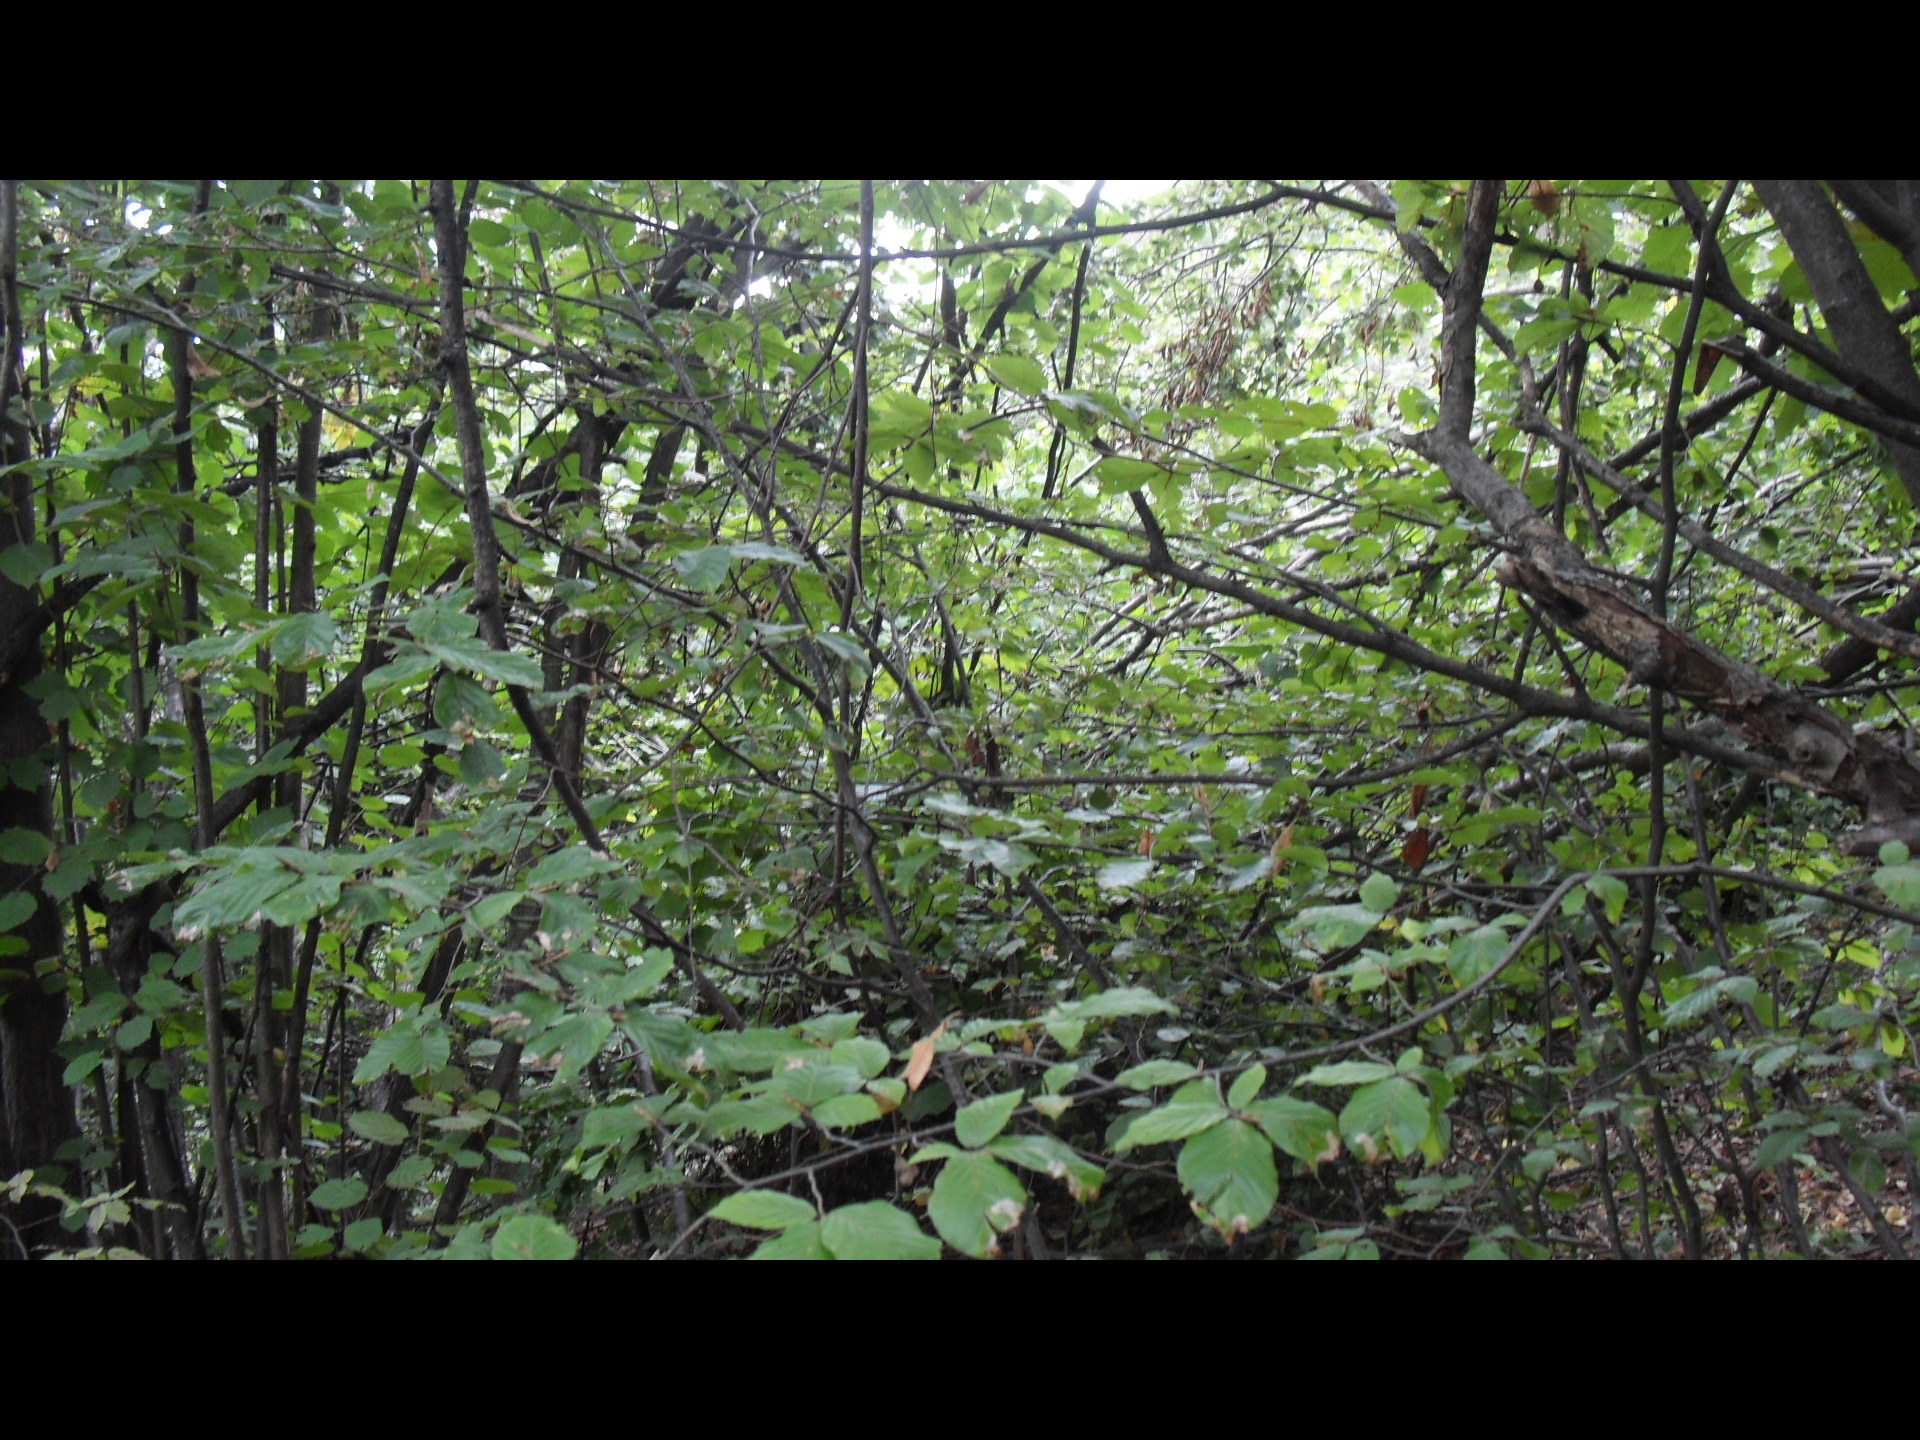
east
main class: Woodland
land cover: Broadleaved woodland
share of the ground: > 75 %
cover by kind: broadleaved forest trees 100 %
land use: Forestry
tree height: < 5 m
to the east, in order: Broadleaved woodland; Tracks; Broadleaved woodland; Tracks; Broadleaved woodland; Tracks
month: October
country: BG
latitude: 43.3678
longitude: 22.8308
